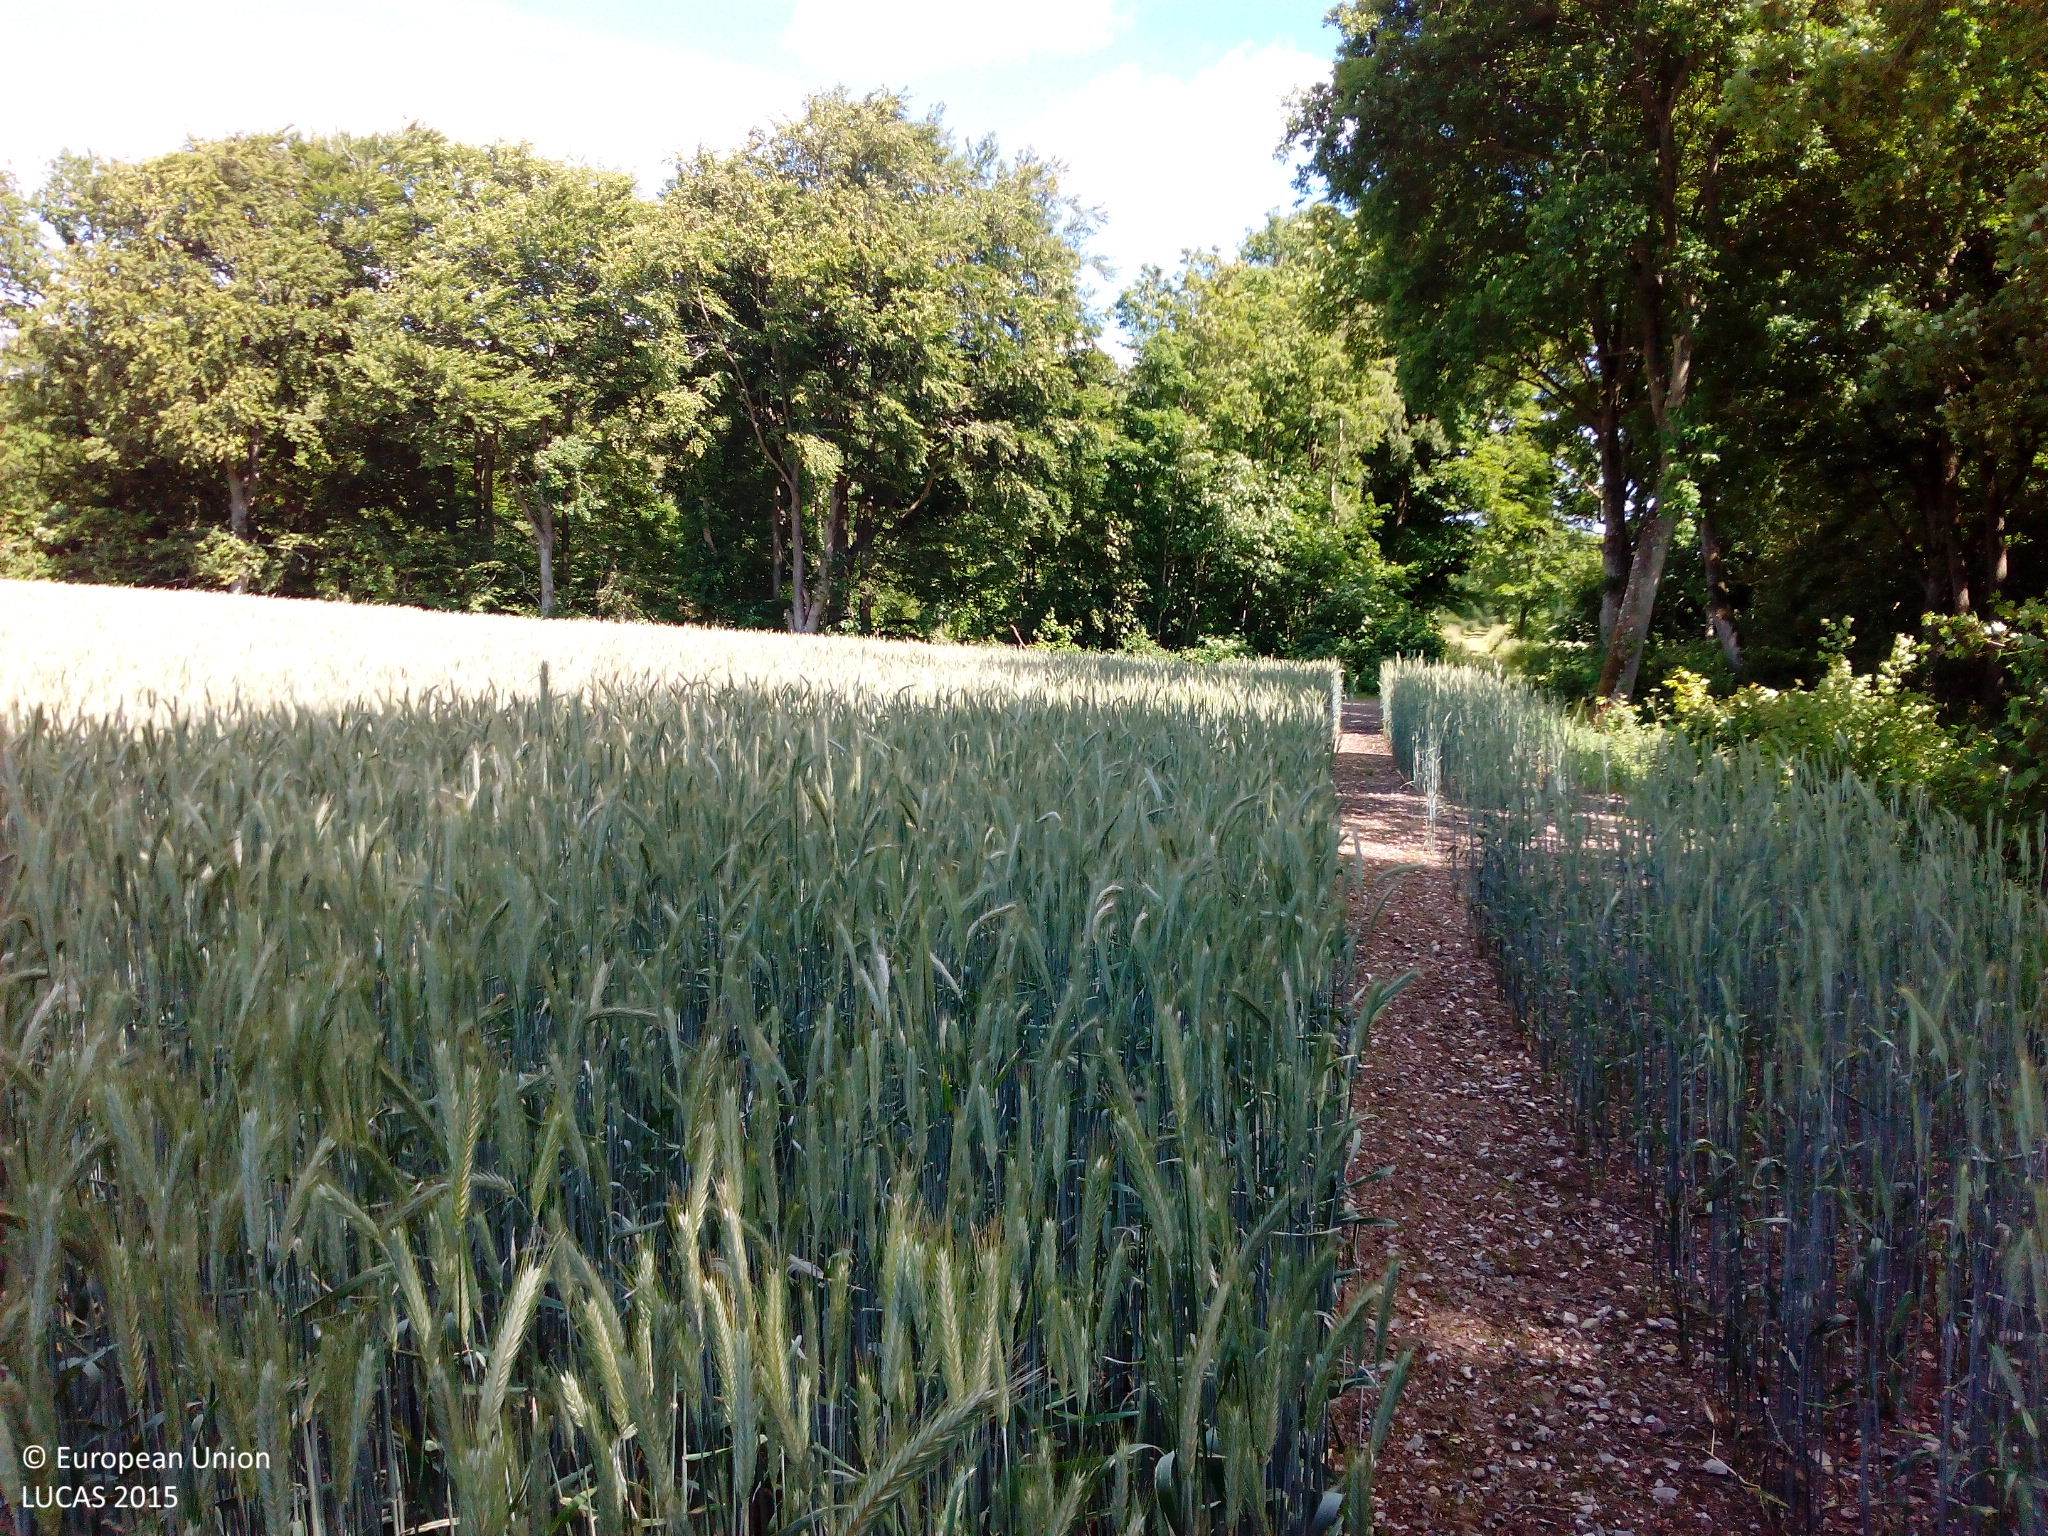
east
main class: Cropland
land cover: Rye
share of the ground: > 75 %
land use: Agriculture (excluding fallow land and kitchen gardens)
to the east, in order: Rye; Tracks; Broadleaved woodland; Rivers and streams; Broadleaved woodland; Grassland without tree/shrub cover; Common wheat
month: June
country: DK
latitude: 56.3291
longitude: 10.7915
